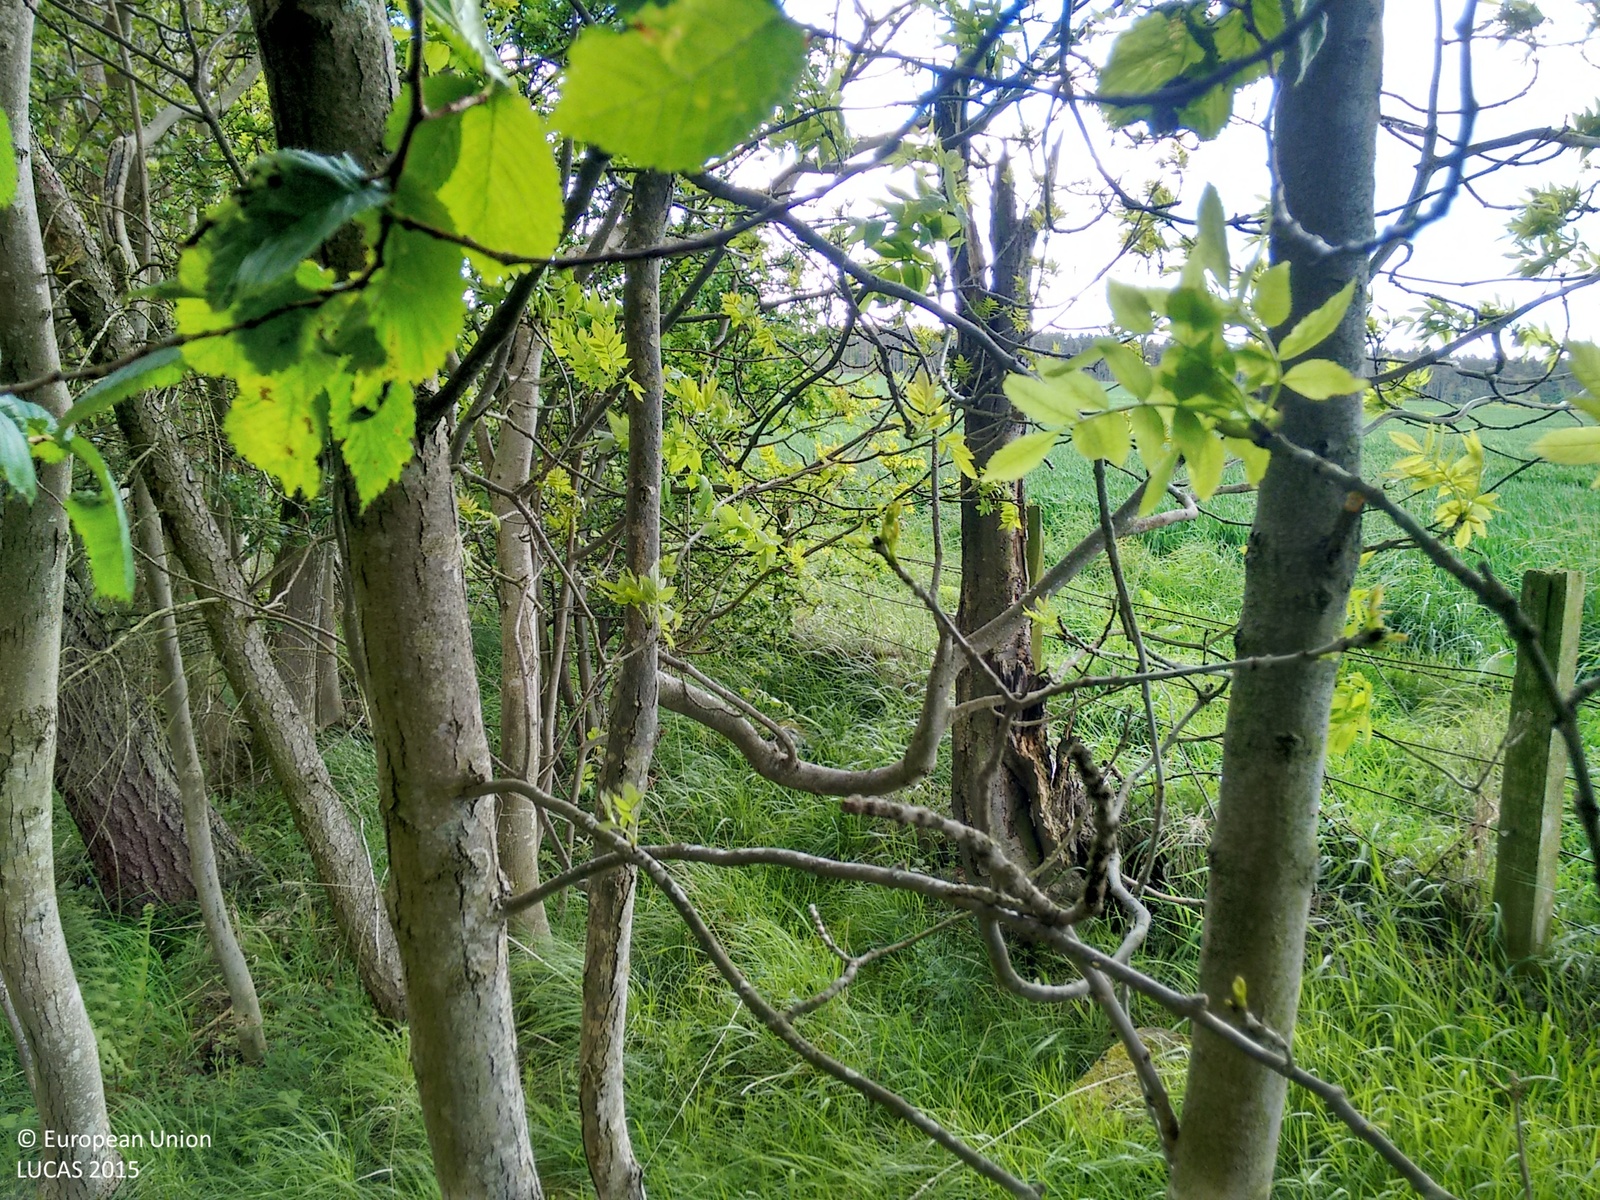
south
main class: Woodland
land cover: Pine dominated mixed woodland
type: exotic forest
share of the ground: > 75 %
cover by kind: coniferous forest trees 65 %, broadleaved forest trees 25 %, herbaceous plants 10 %
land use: Semi-natural and natural areas not in use
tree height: > 5 m
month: May
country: GB
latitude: 55.9097
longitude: -2.7823
